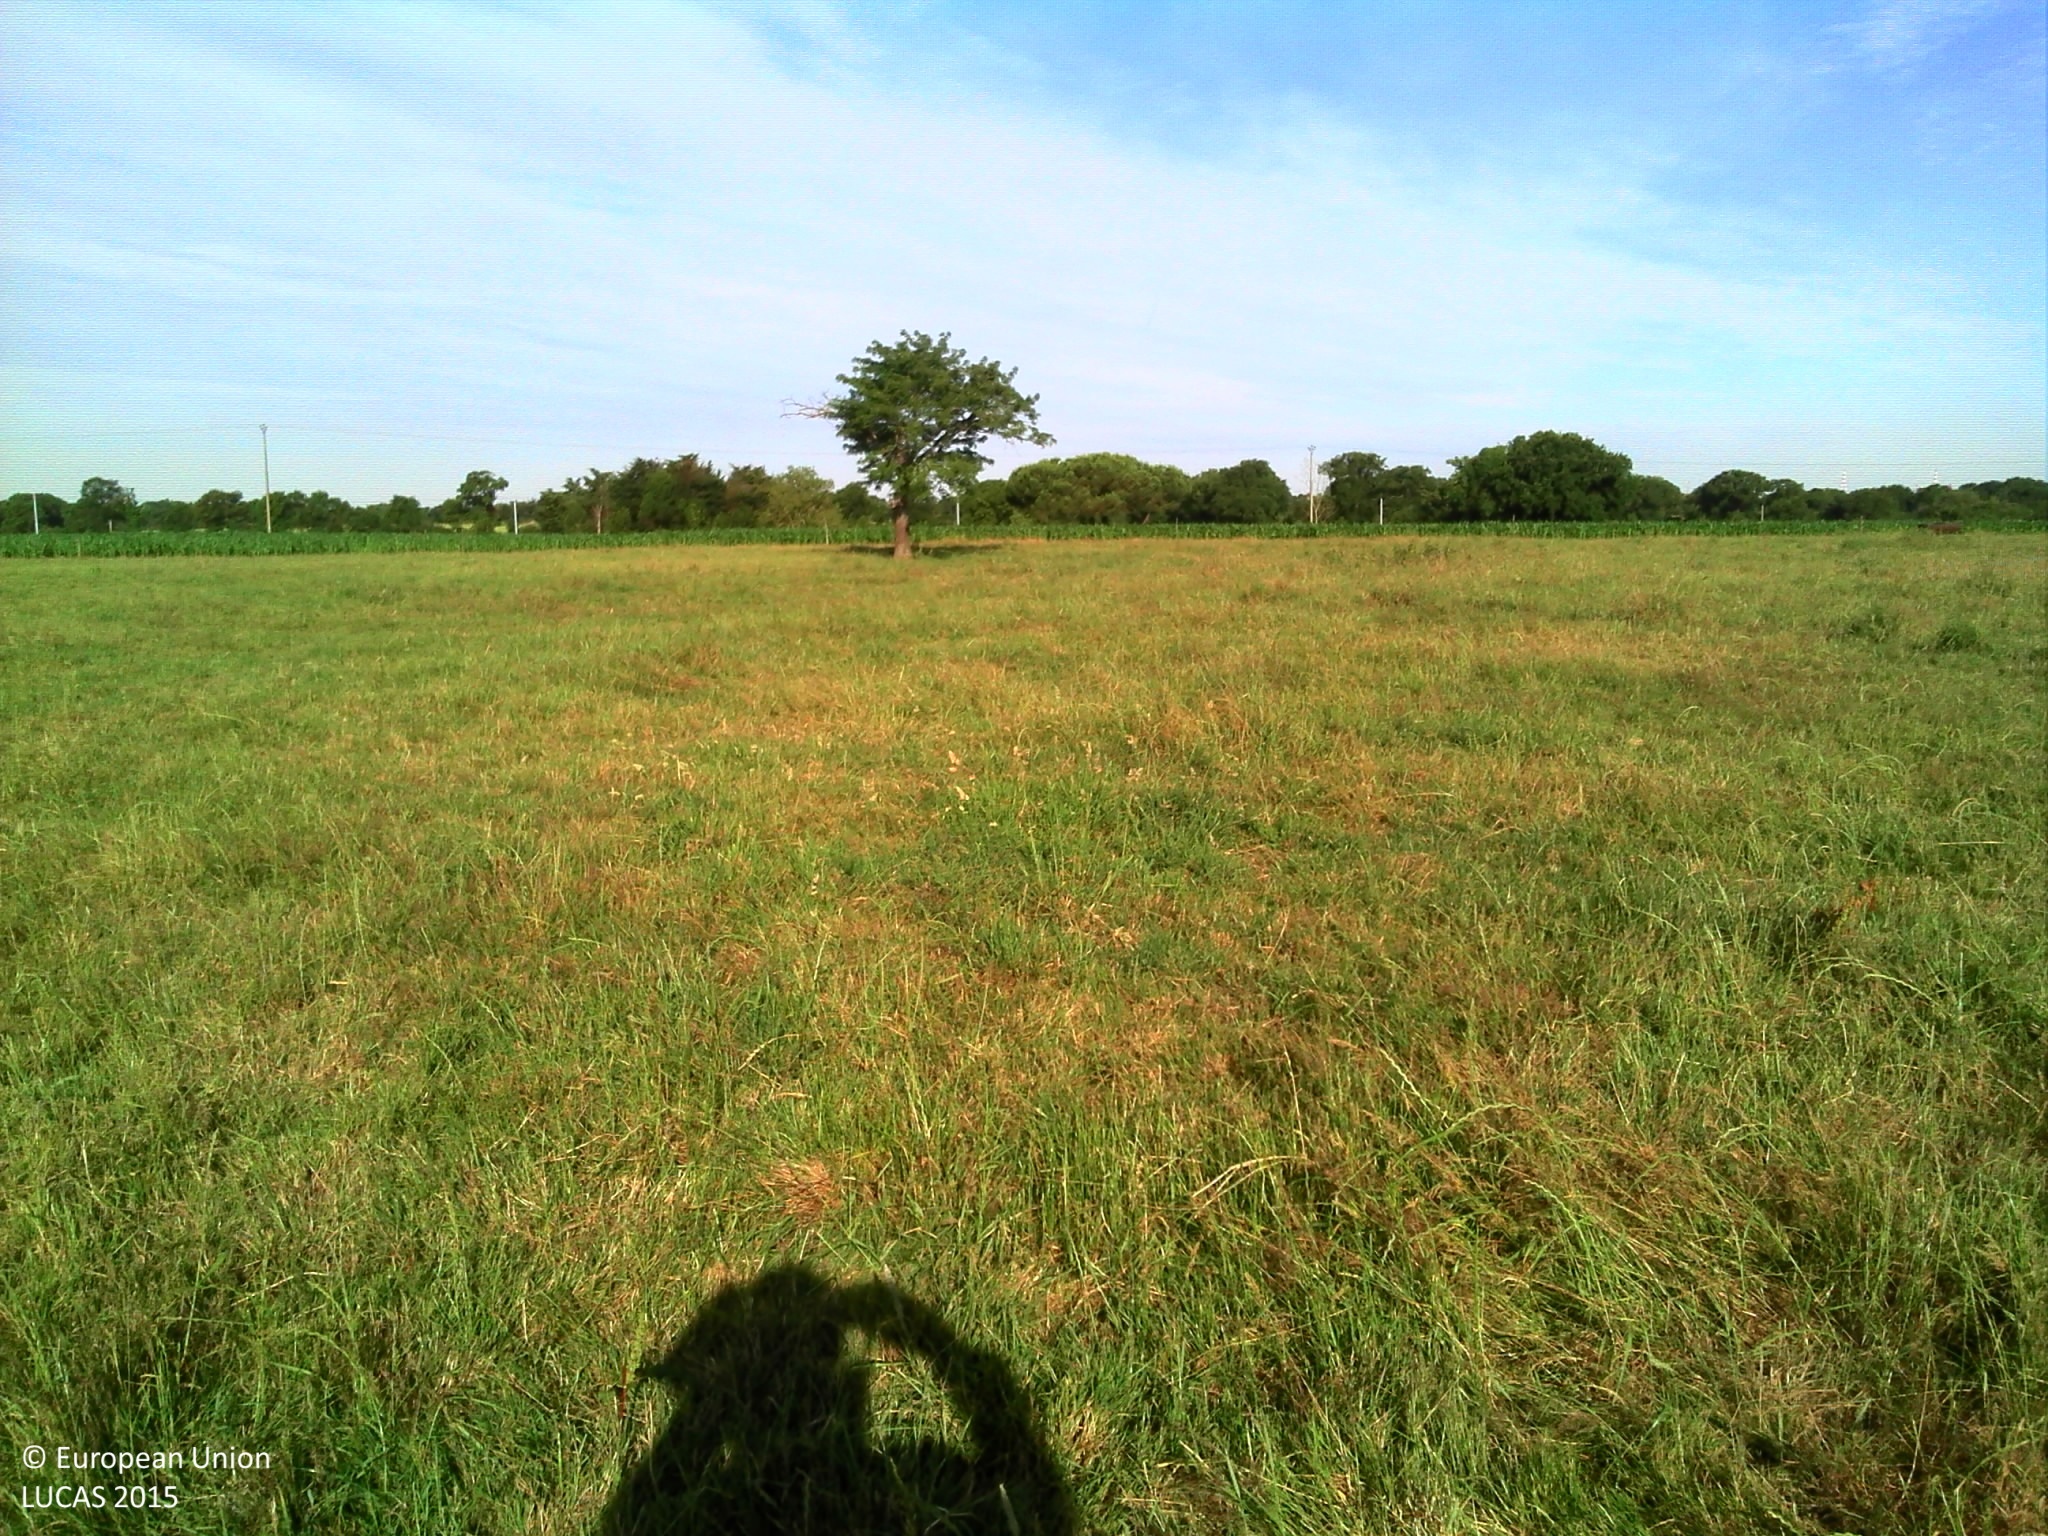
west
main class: Cropland
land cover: Temporary grasslands
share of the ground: > 75 %
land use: Agriculture (excluding fallow land and kitchen gardens)
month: June
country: FR
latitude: 47.2642
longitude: -2.0897
